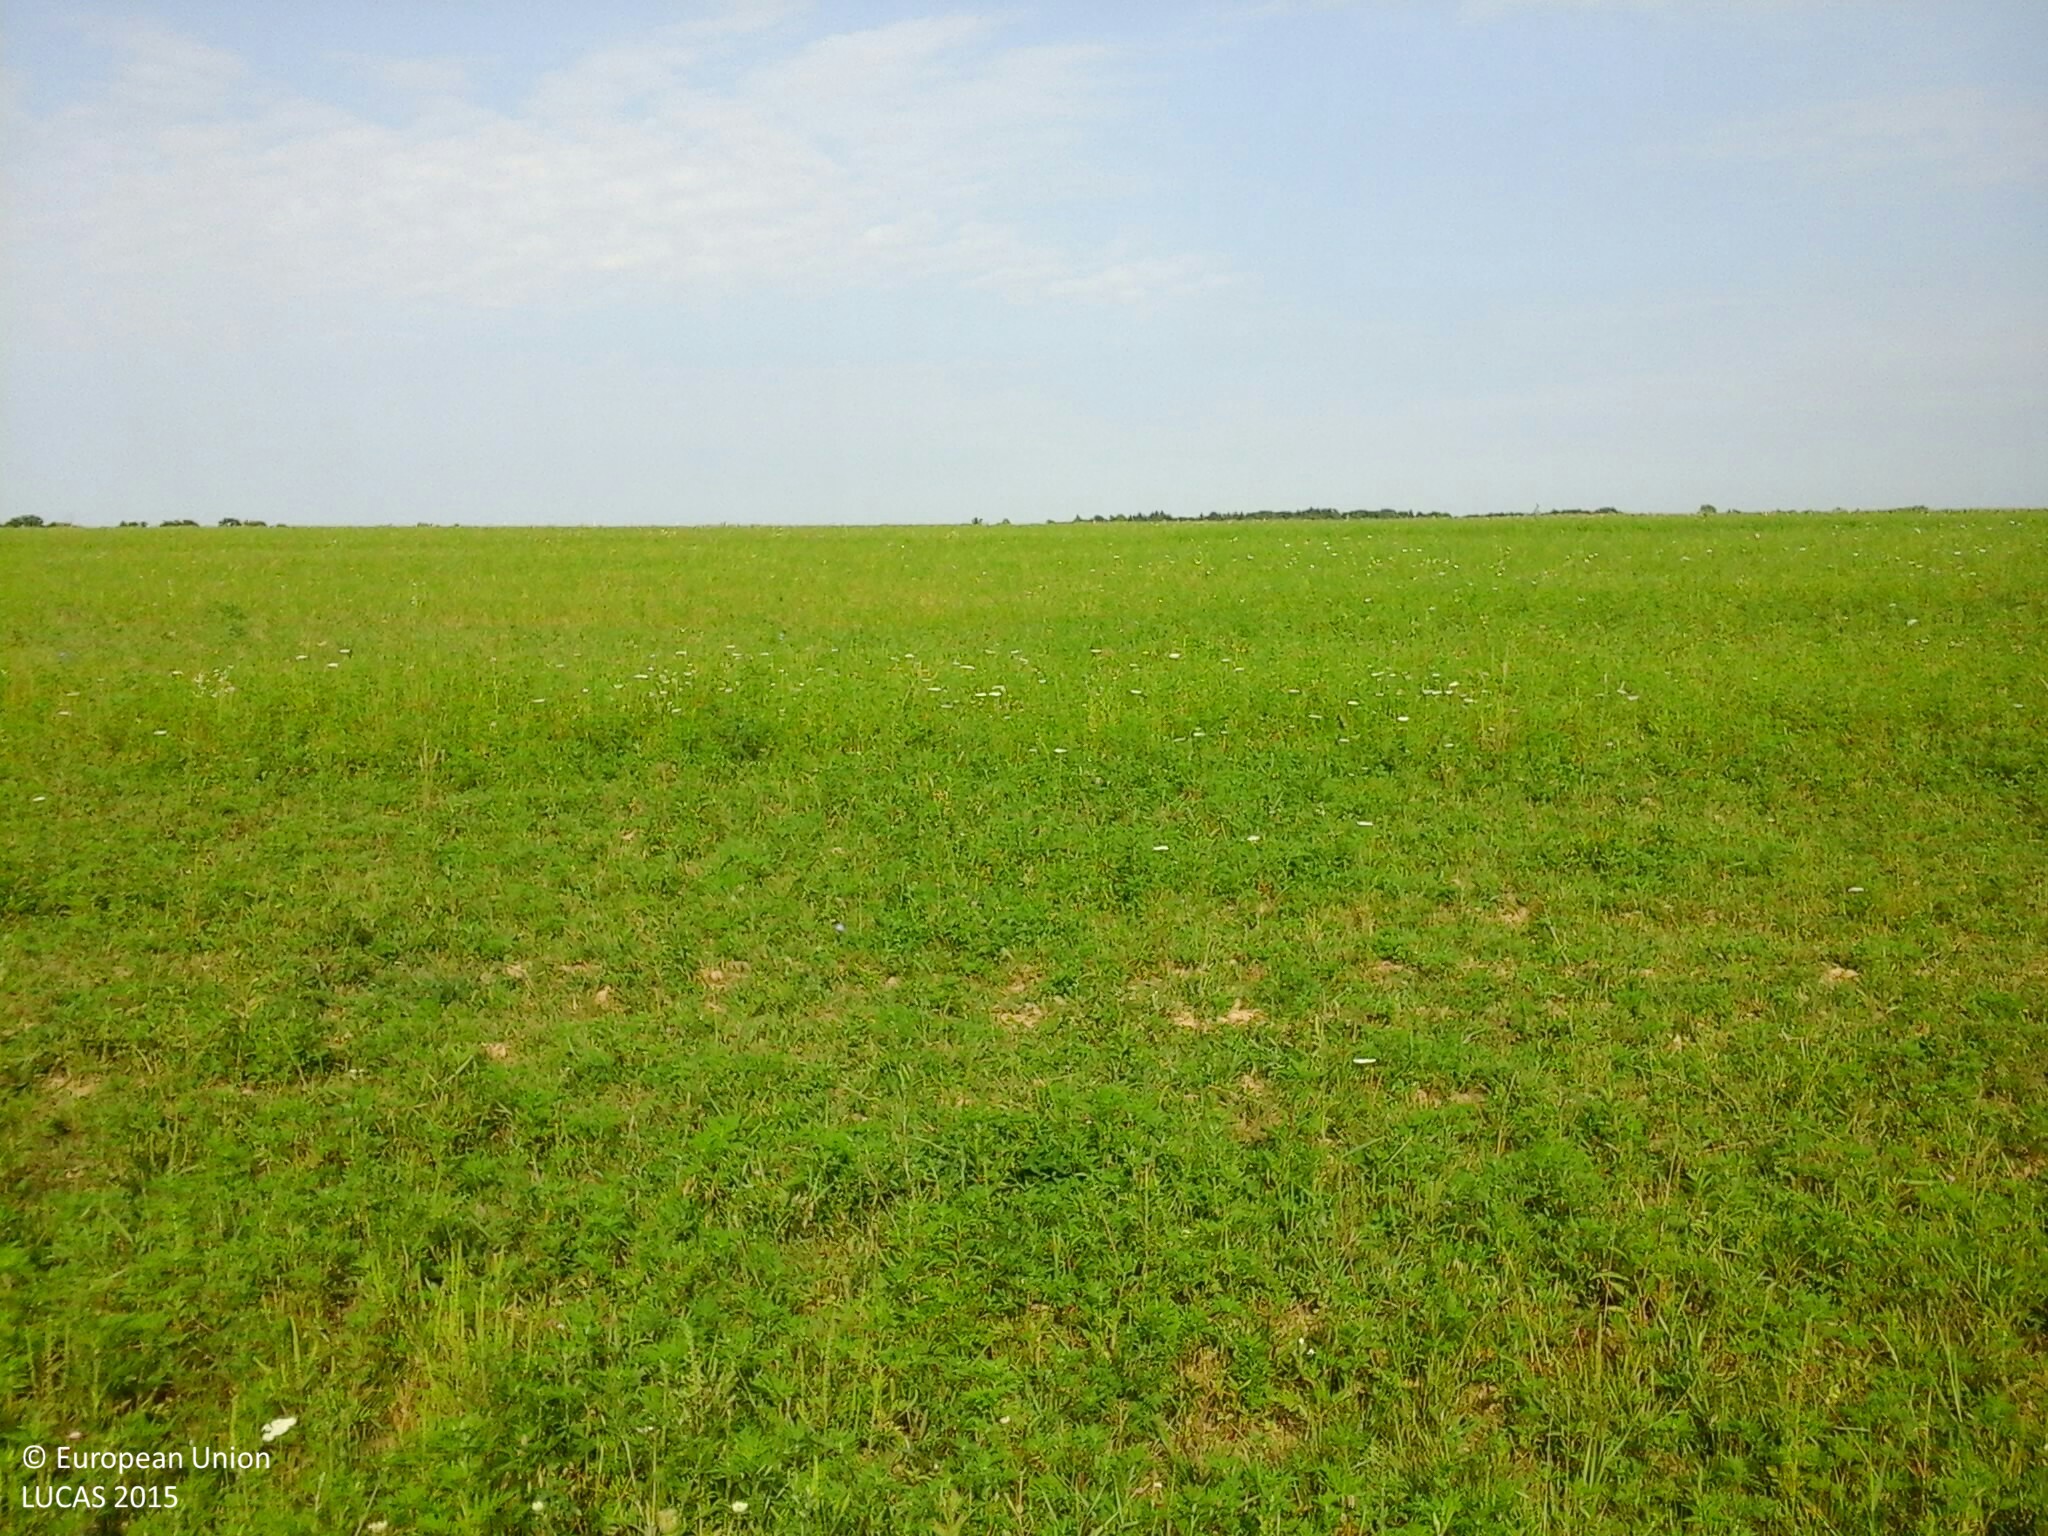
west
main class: Grassland
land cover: Grassland without tree/shrub cover
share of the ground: > 75 %
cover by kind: herbaceous plants 100 %
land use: Abandoned areas
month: July
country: HU
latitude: 46.8435
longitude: 16.4404
